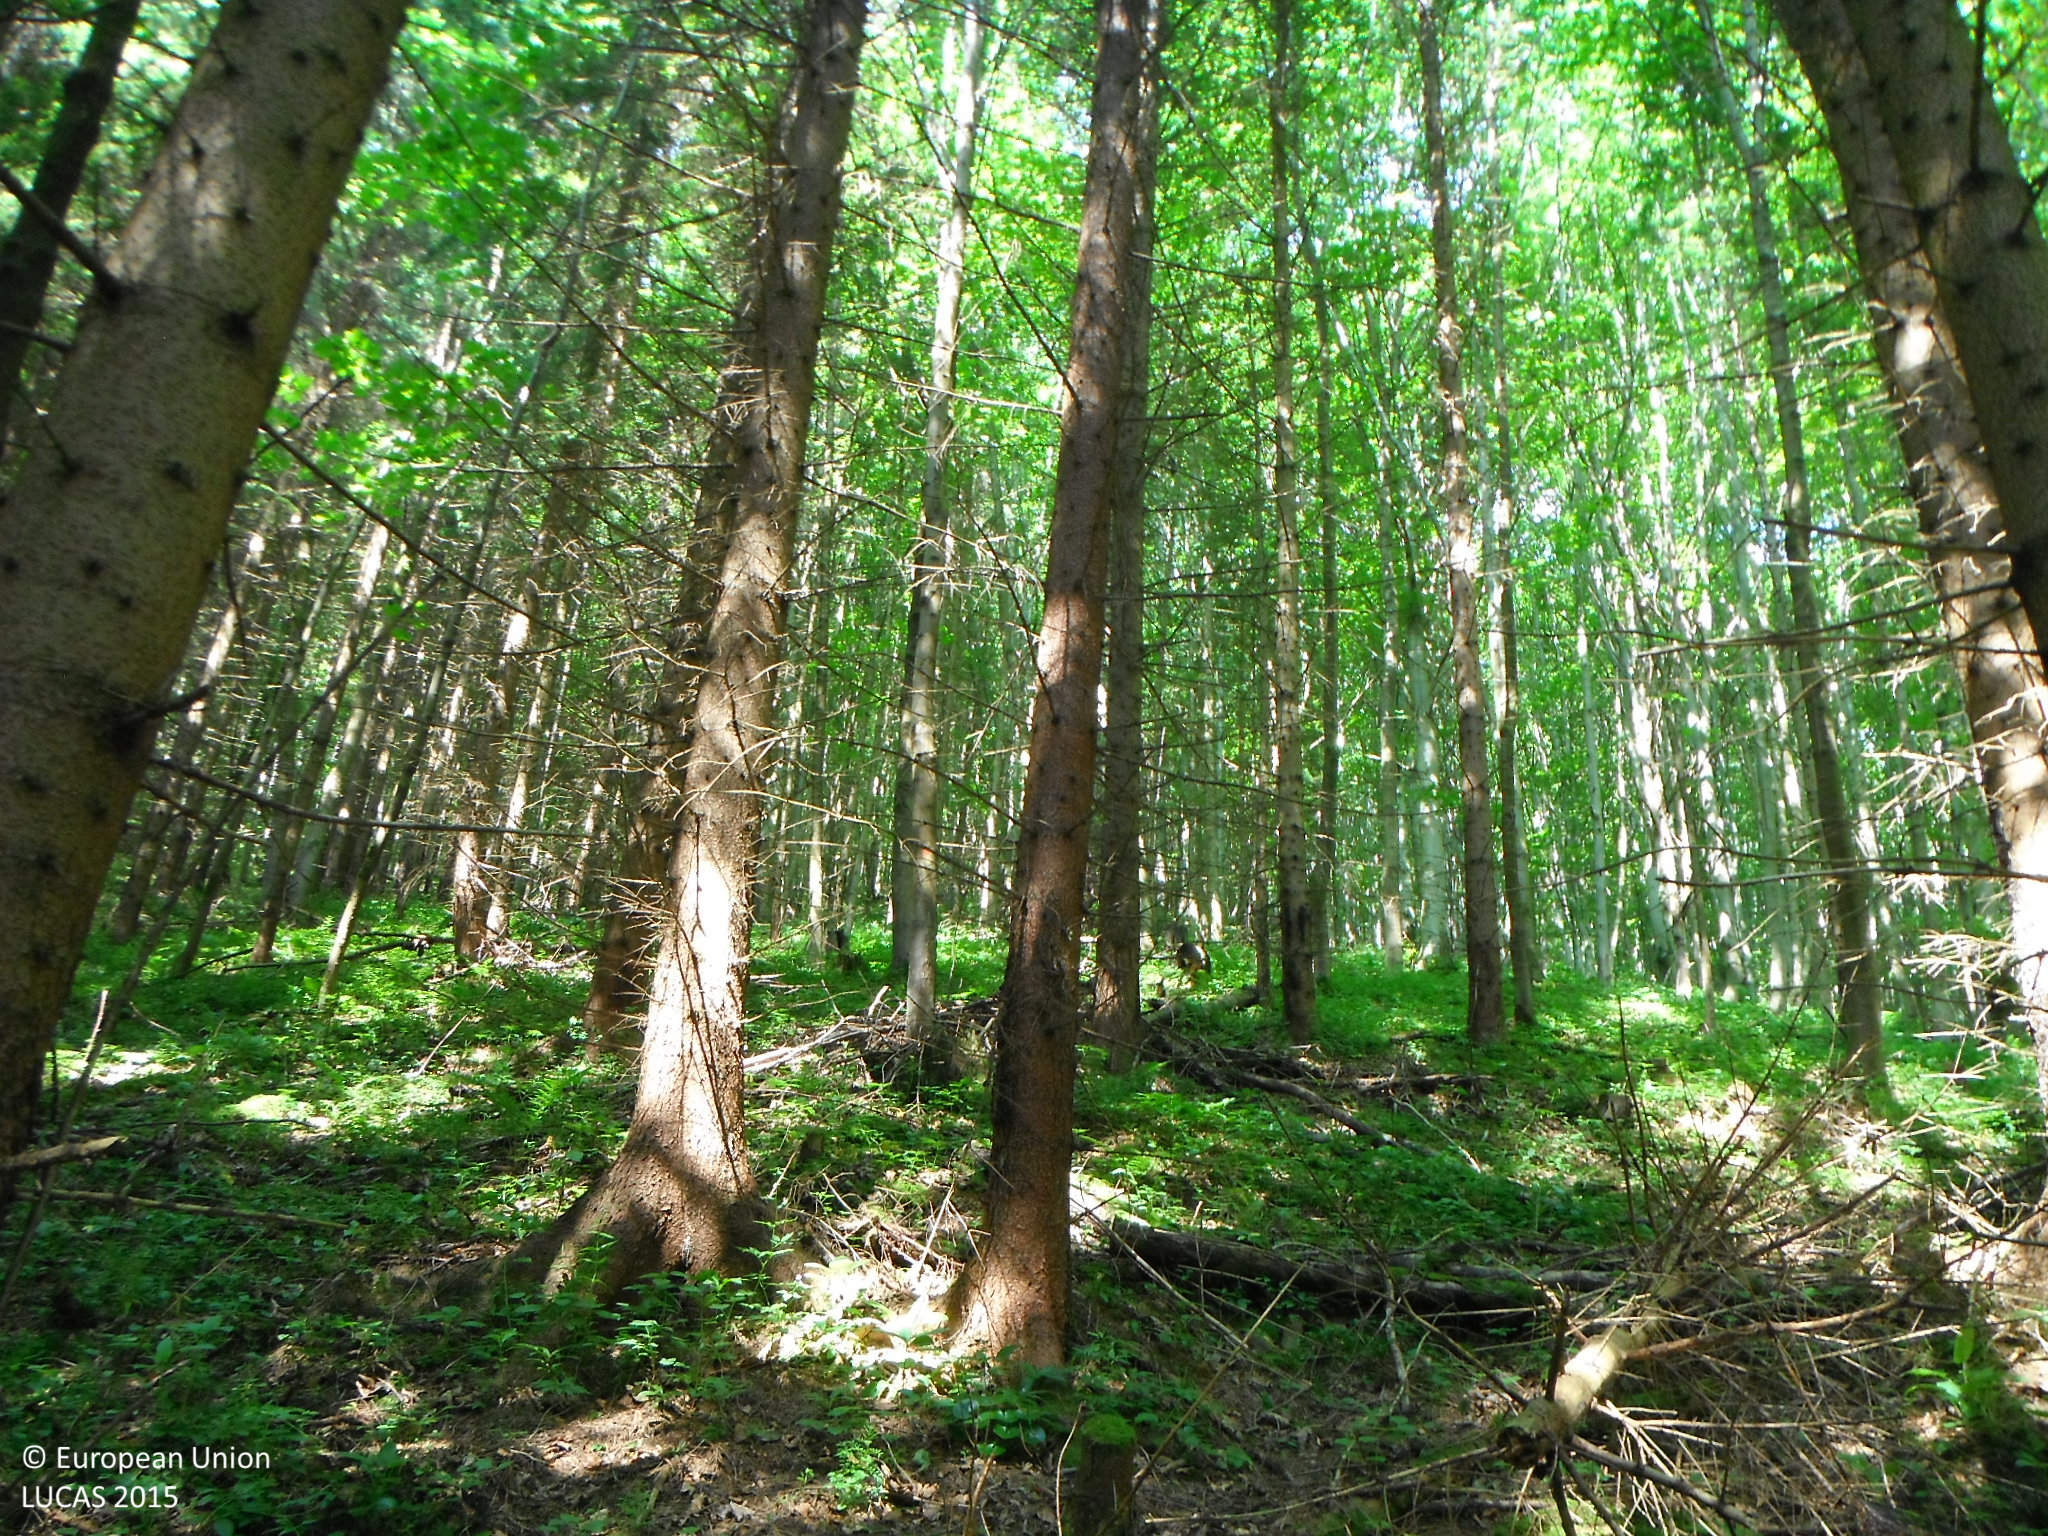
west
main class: Woodland
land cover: Spruce dominated mixed woodland
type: alpine coniferous forest
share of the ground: > 75 %
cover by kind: coniferous forest trees 70 %, broadleaved forest trees 30 %
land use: Forestry
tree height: > 5 m
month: June
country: SK
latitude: 49.0554
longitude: 19.1502
